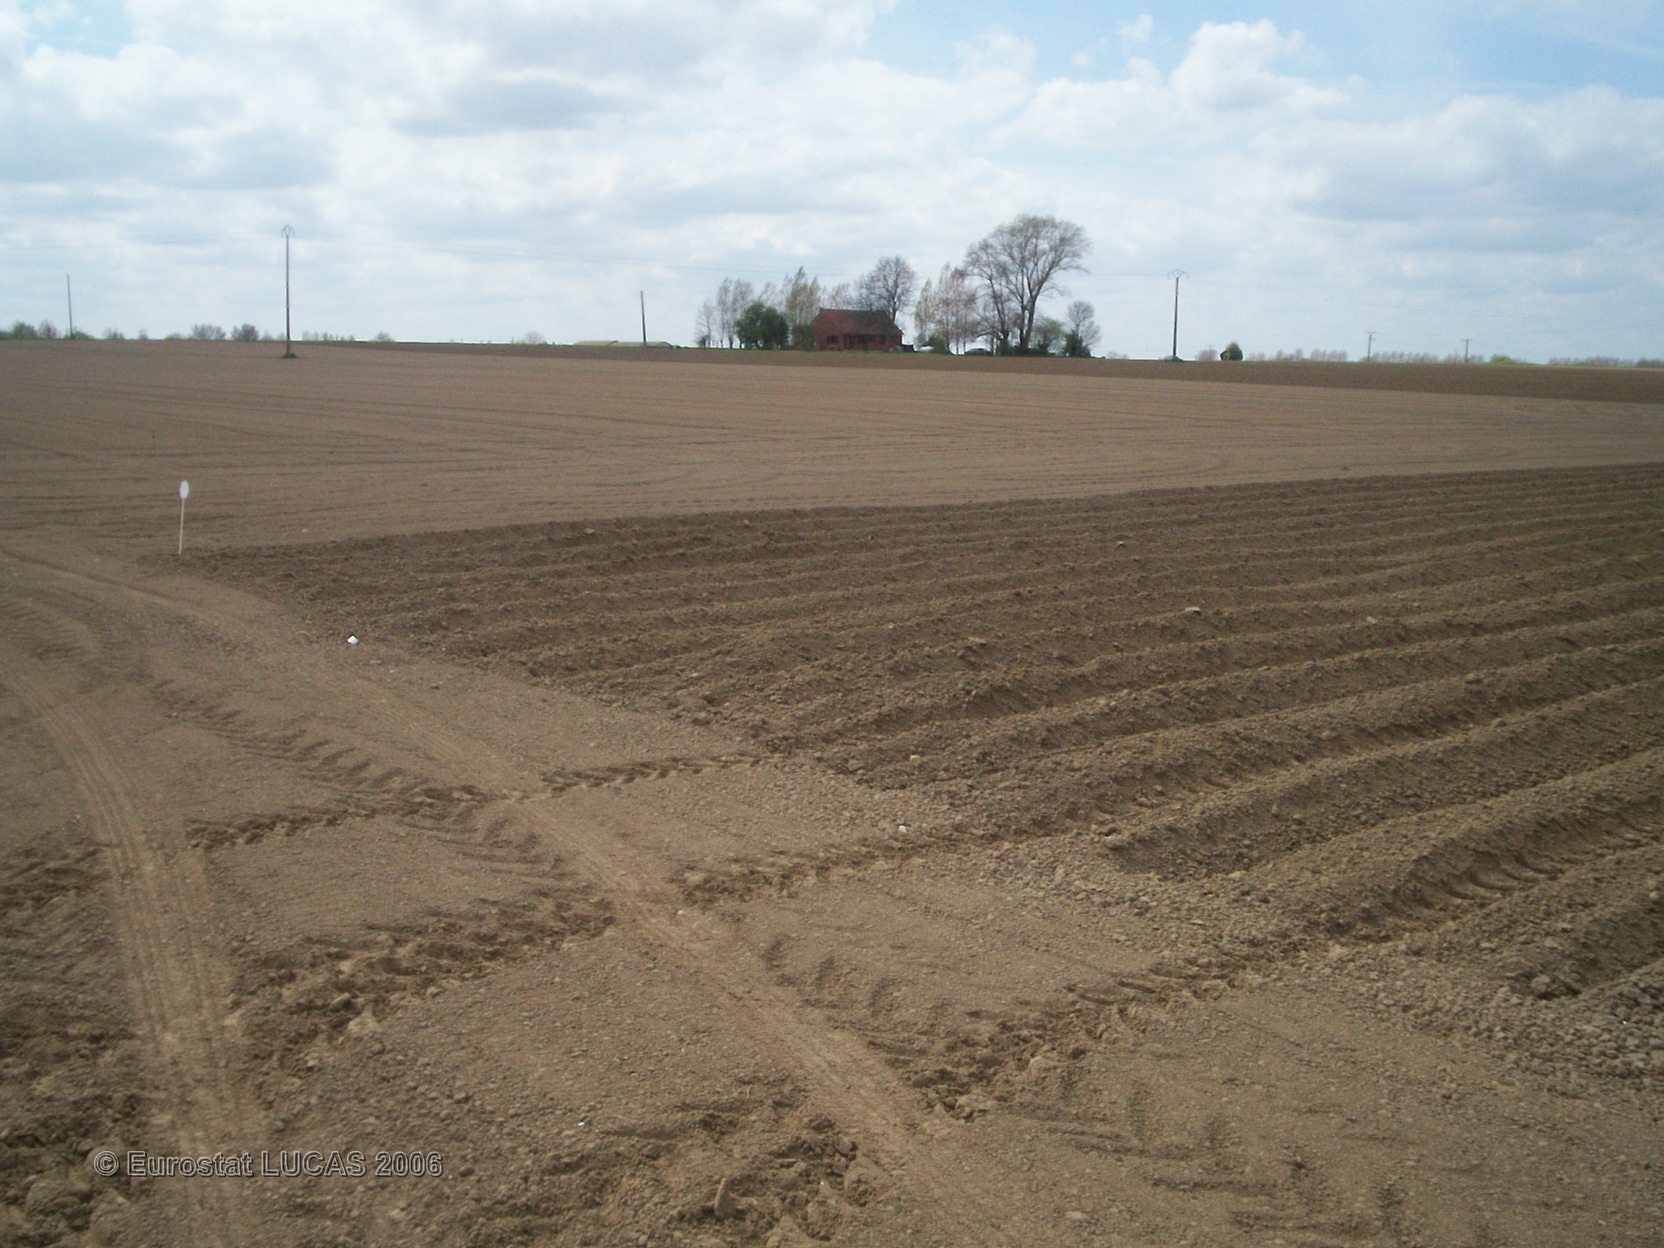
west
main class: Cropland
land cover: Other fresh vegetables
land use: Agriculture (excluding fallow land and kitchen gardens)
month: June
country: FR
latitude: 50.8618
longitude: 2.5571
